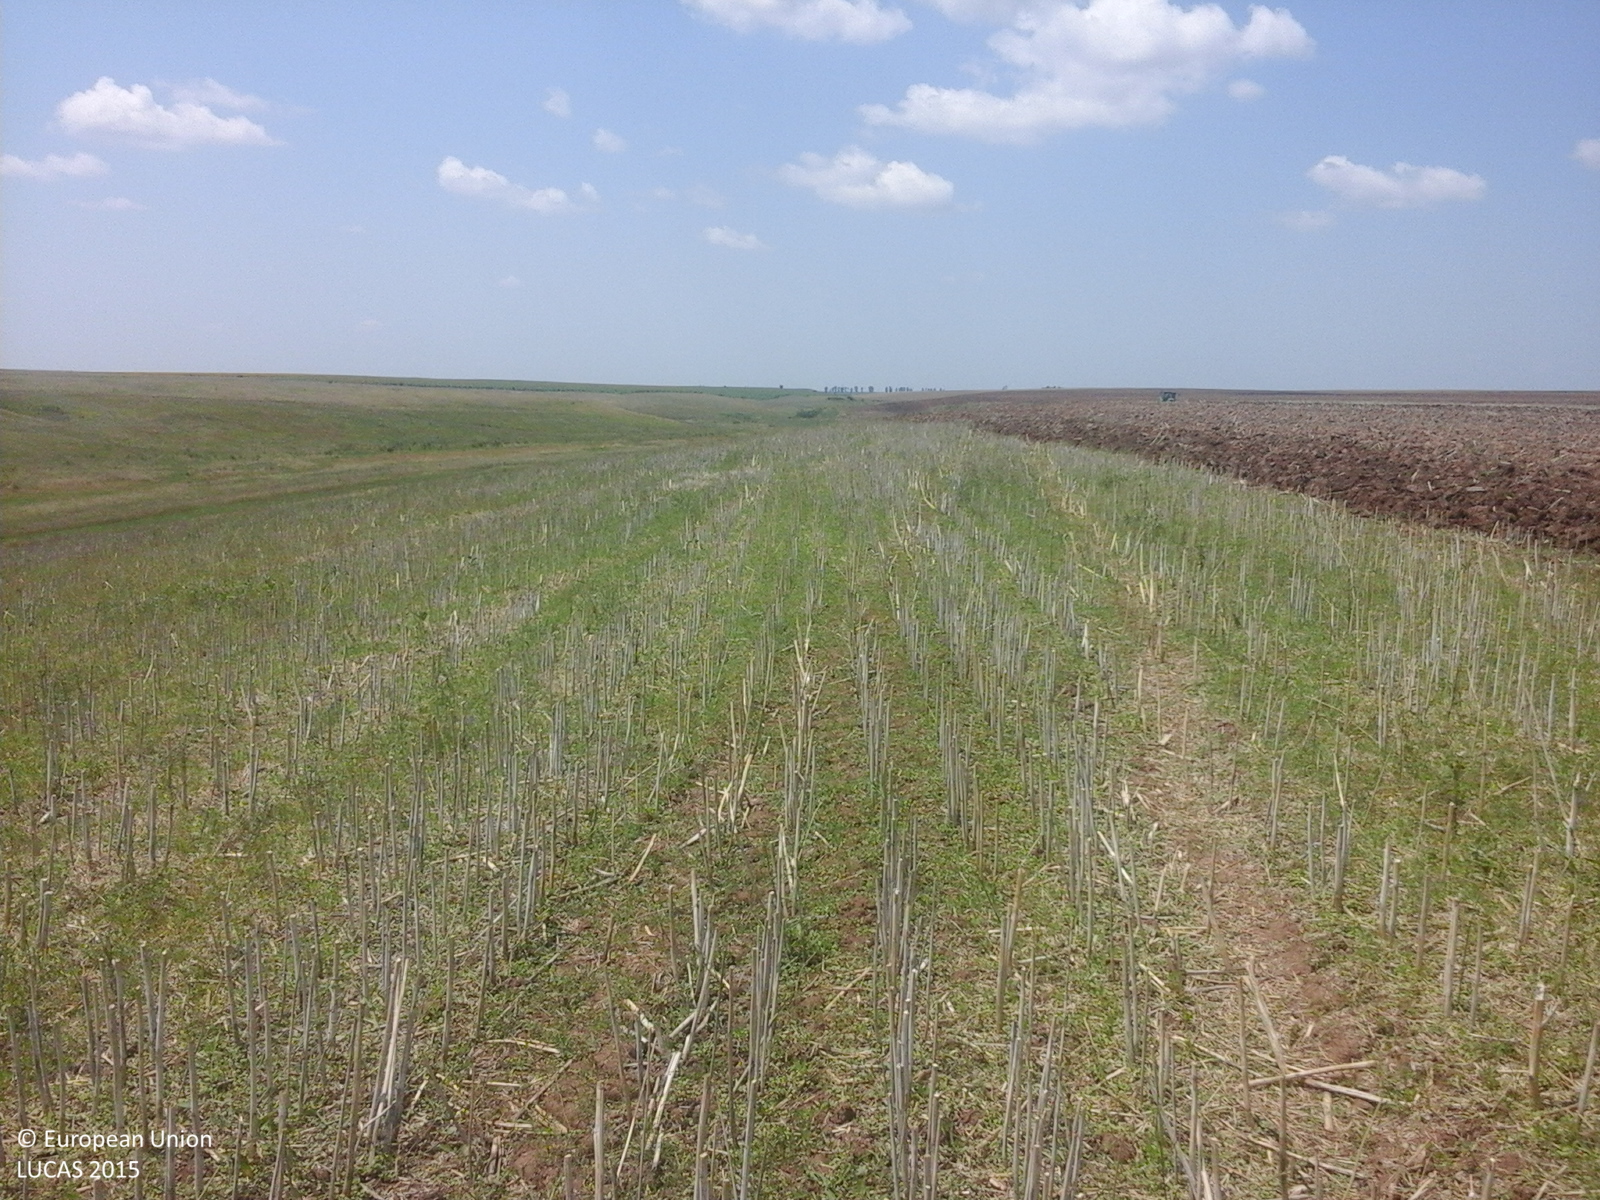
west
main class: Cropland
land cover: Rape and turnip rape
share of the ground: < 10 %
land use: Agriculture (excluding fallow land and kitchen gardens)
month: July
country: RO
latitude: 44.1787
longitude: 24.1589
